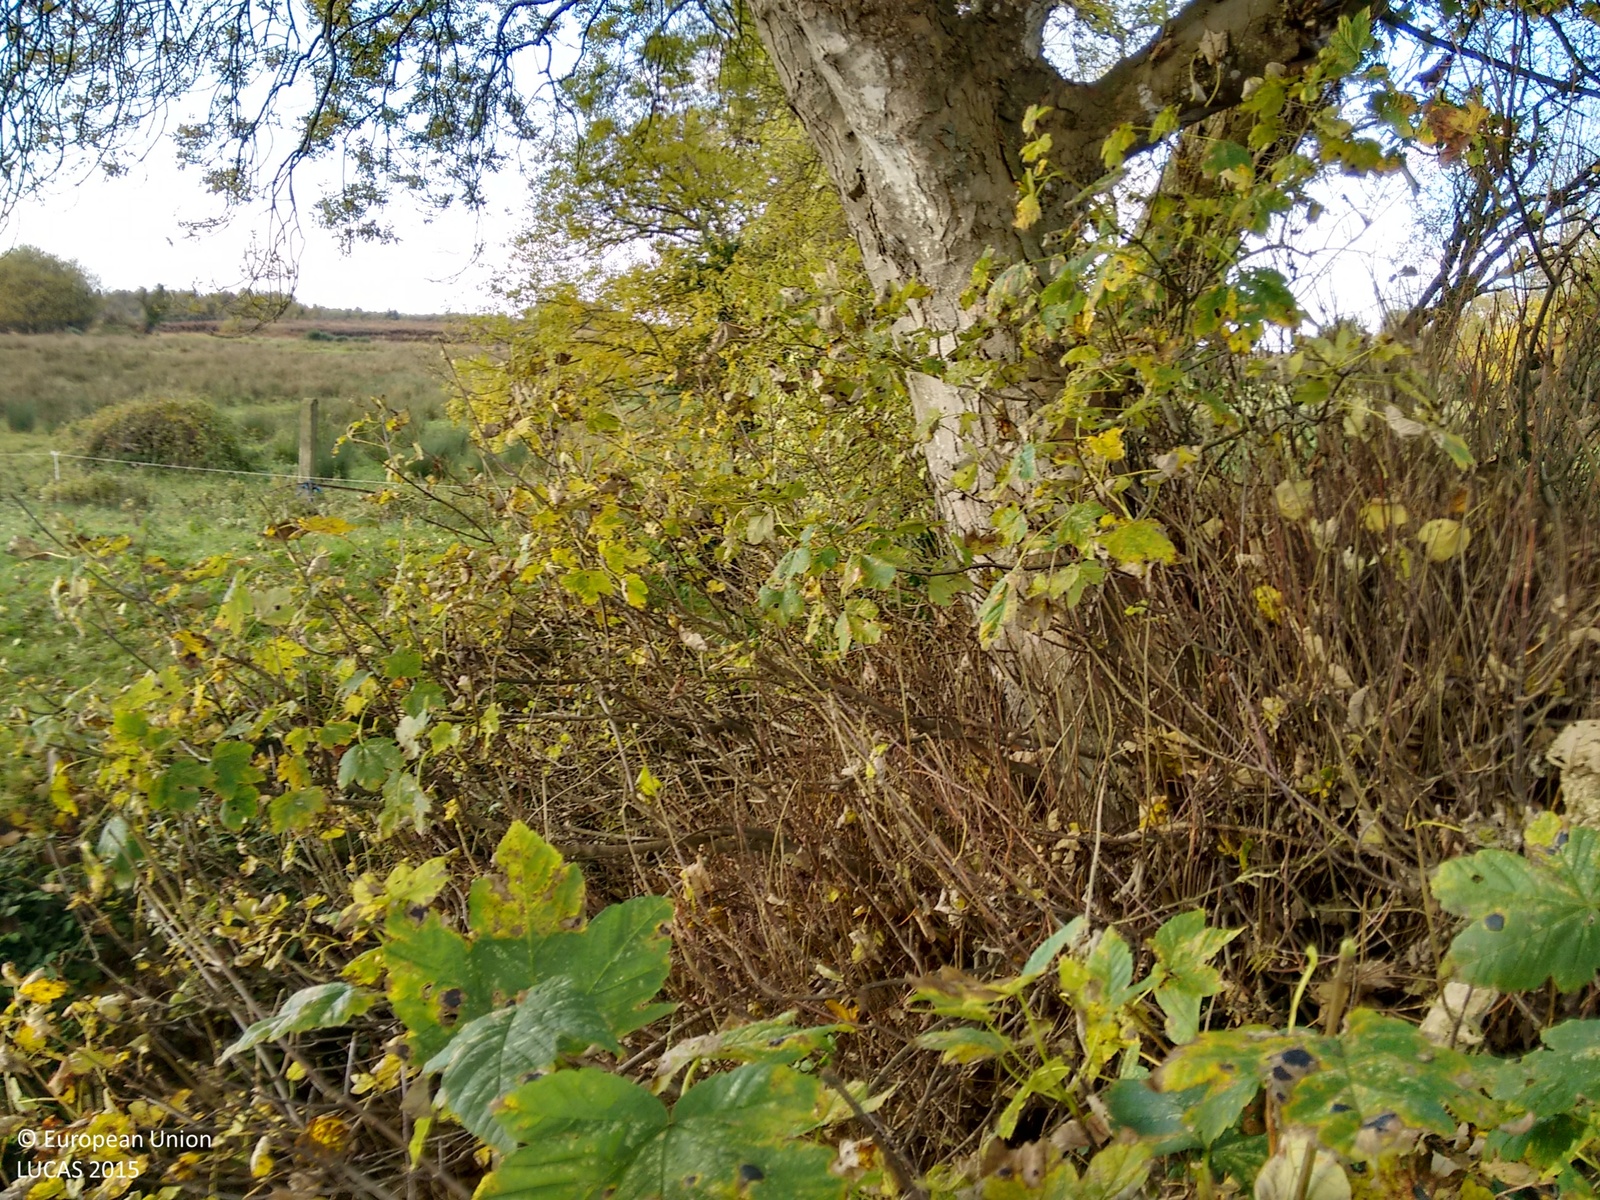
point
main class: Grassland
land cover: Grassland without tree/shrub cover
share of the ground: > 75 %
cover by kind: herbaceous plants 80 %, shrubs 5 %
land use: Agriculture (excluding fallow land and kitchen gardens)
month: October
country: IE
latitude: 53.3116
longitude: -7.6176
